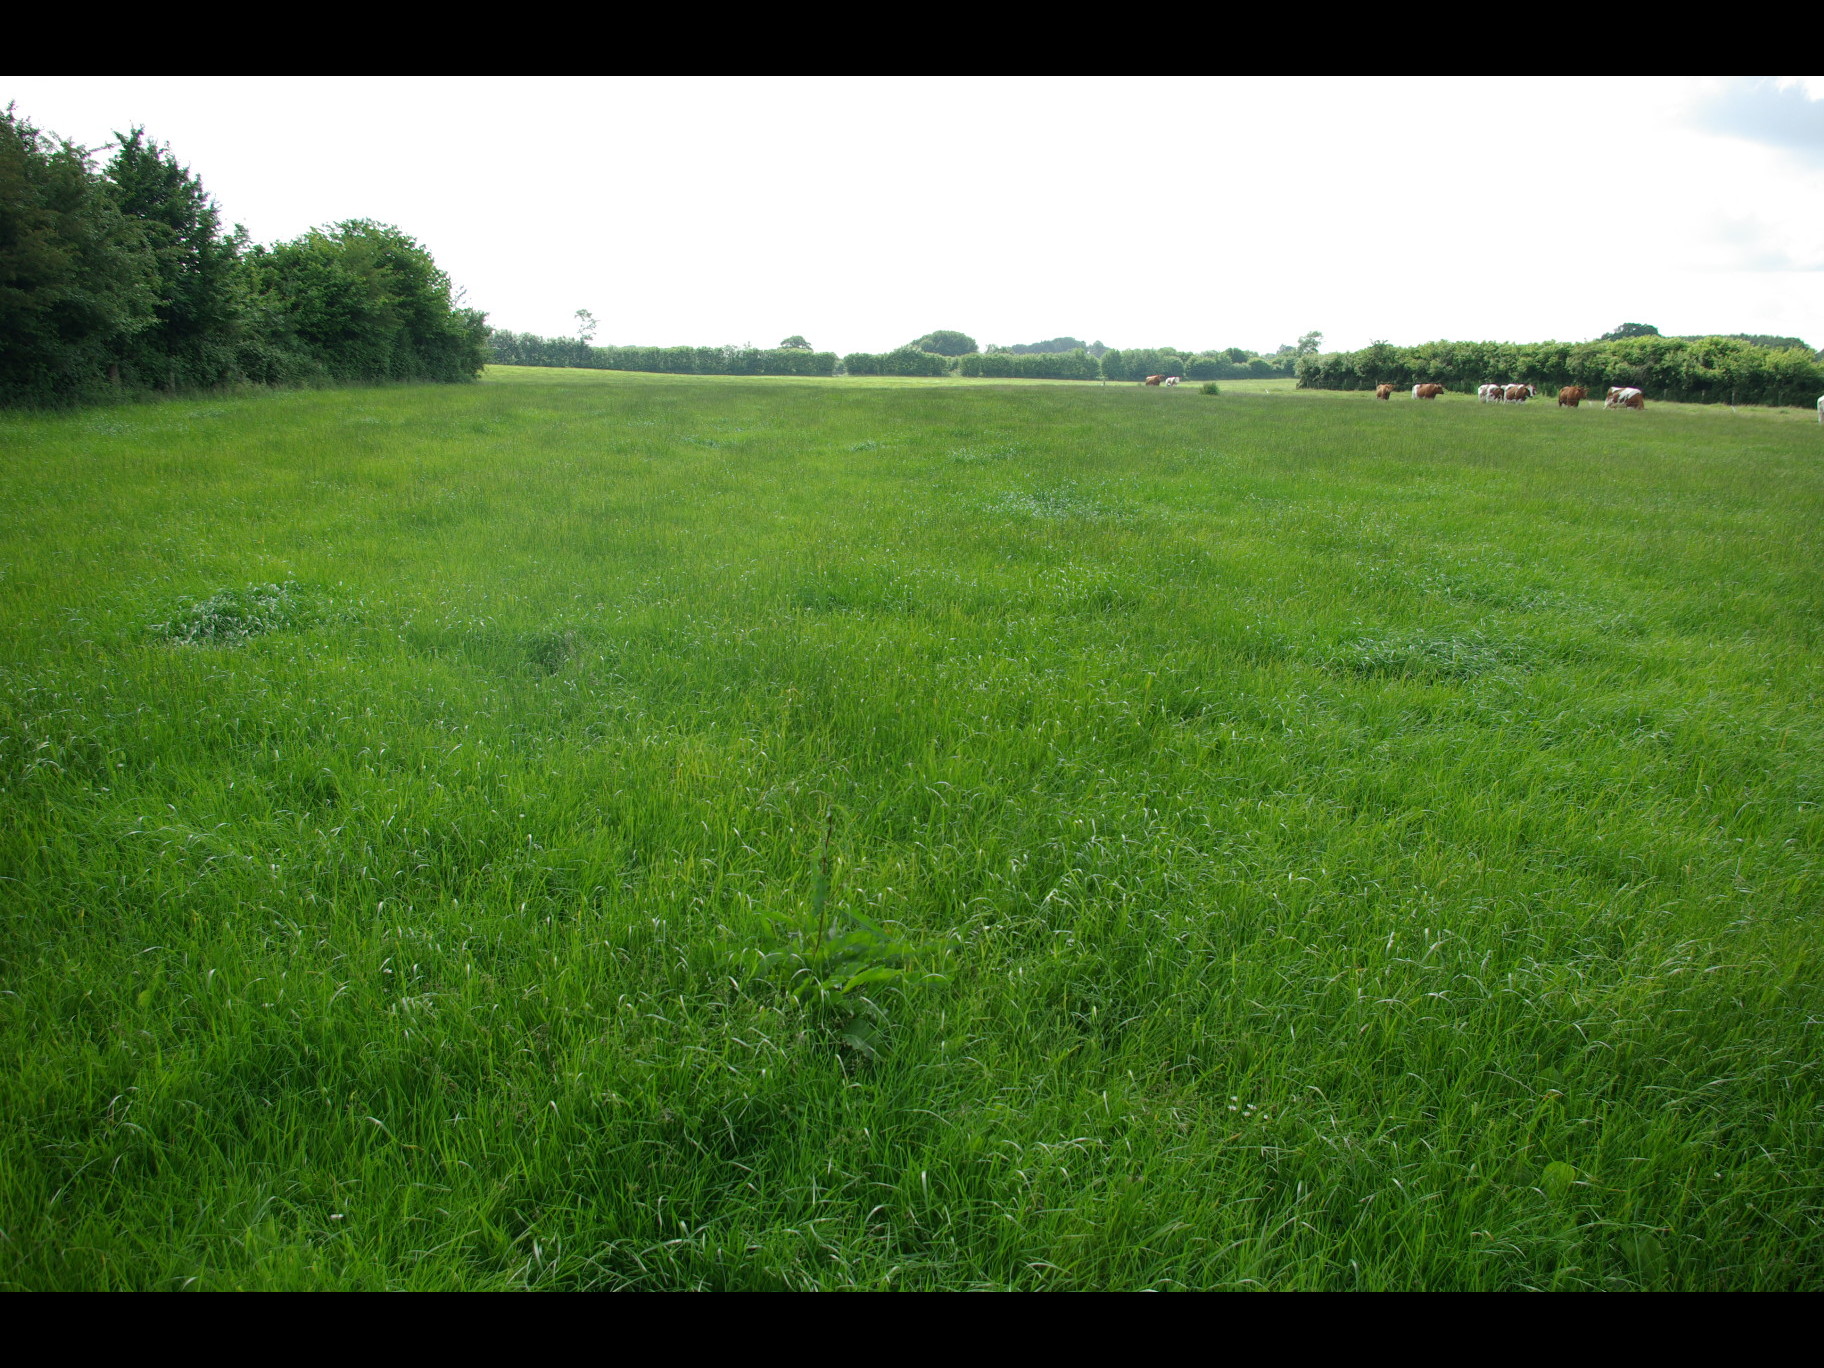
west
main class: Grassland
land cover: Grassland without tree/shrub cover
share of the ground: > 75 %
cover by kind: herbaceous plants 100 %
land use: Agriculture (excluding fallow land and kitchen gardens)
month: June
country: DE
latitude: 54.2107
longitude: 9.9540
